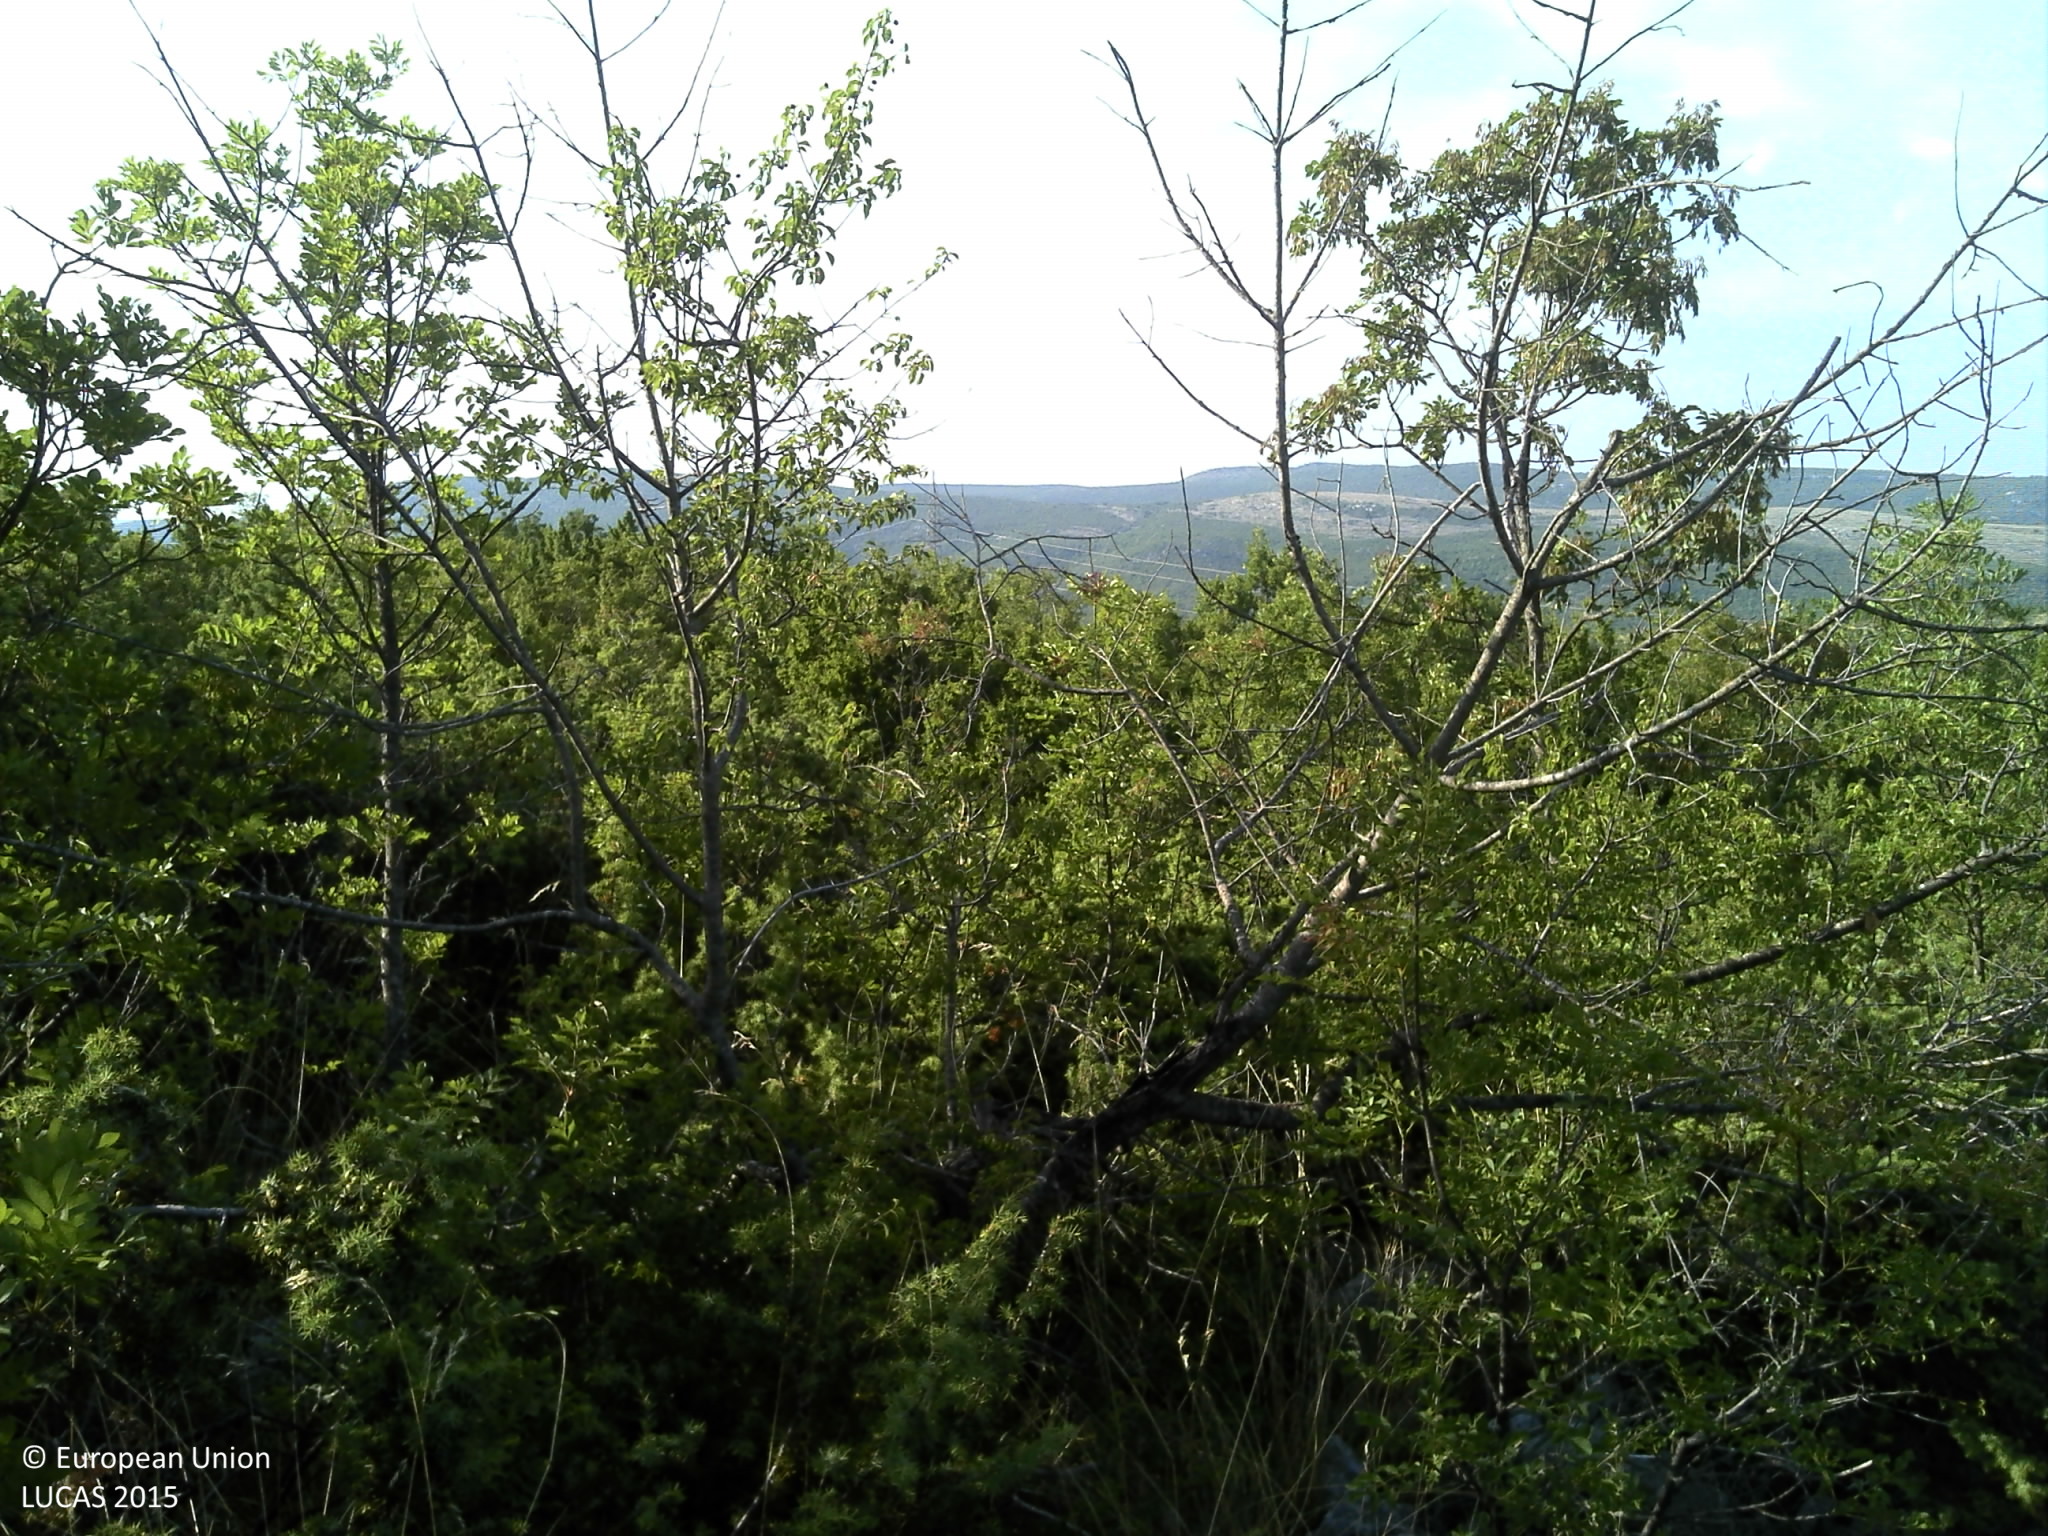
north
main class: Shrubland
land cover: Shrubland with sparse tree cover
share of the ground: > 75 %
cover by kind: shrubs 70 %, consolidated bare surface 15 %, unconsolidated bare surface 10 %, broadleaved forest trees 5 %
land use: Semi-natural and natural areas not in use
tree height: < 5 m
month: June
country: HR
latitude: 43.5985
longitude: 16.2963
